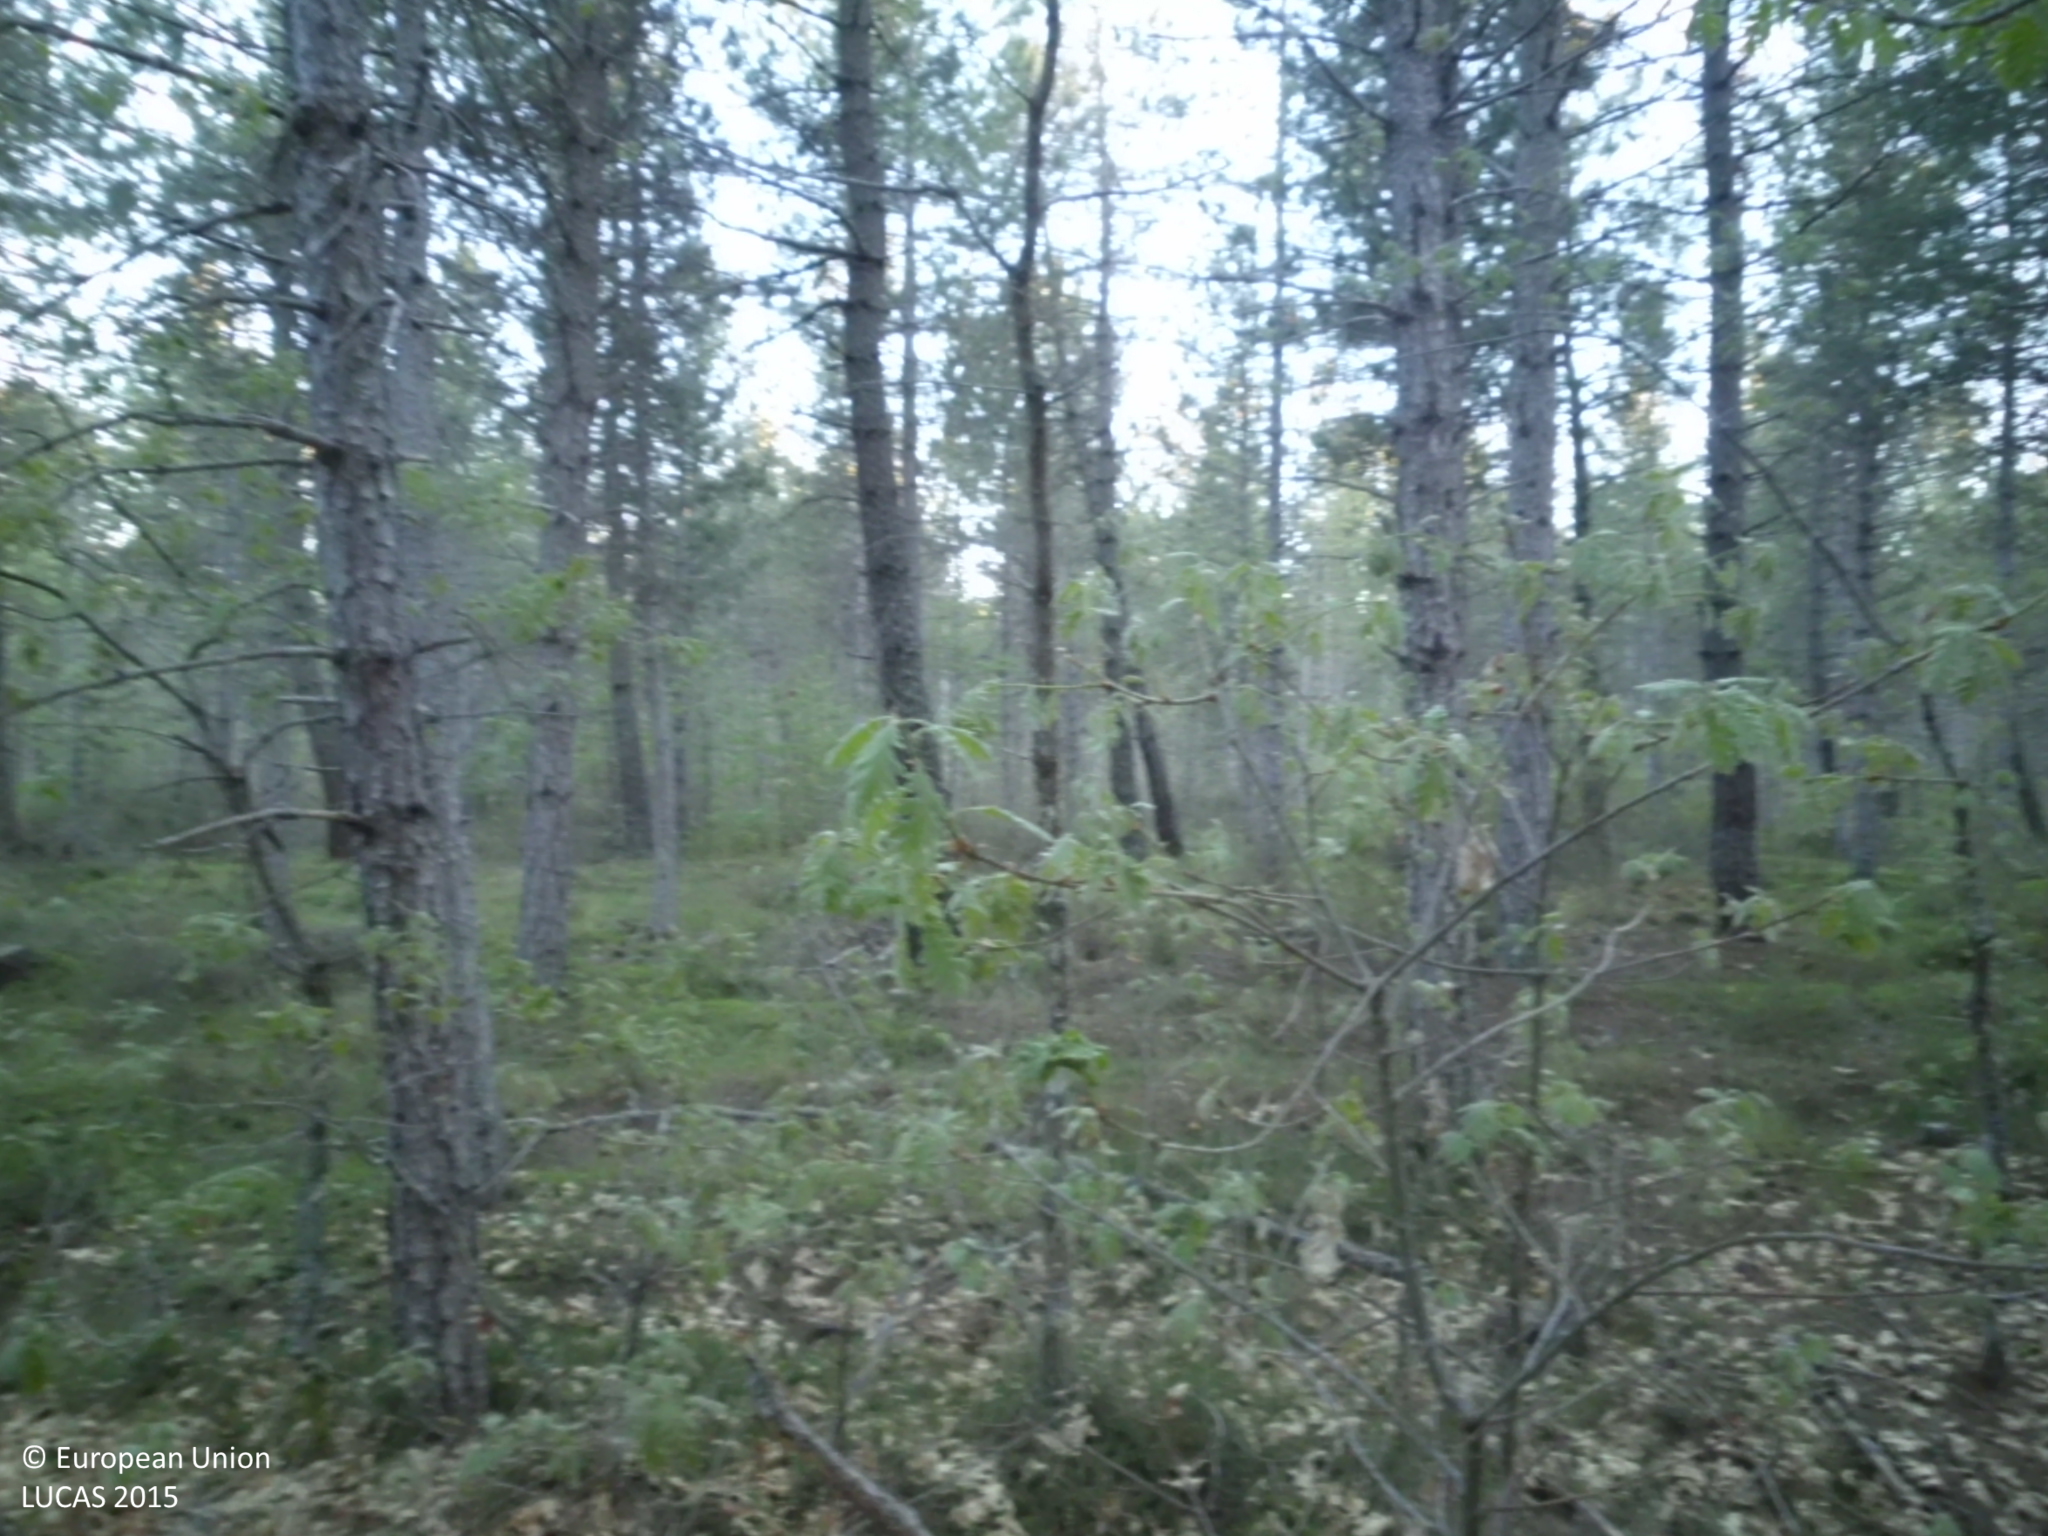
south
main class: Woodland
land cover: Pine dominated coniferous woodland
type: coniferous forest of the mediterranean region
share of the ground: > 75 %
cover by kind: coniferous forest trees 100 %
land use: Forestry
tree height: > 5 m
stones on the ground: > 50 %
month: May
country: ES
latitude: 42.6124
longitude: -4.8704
